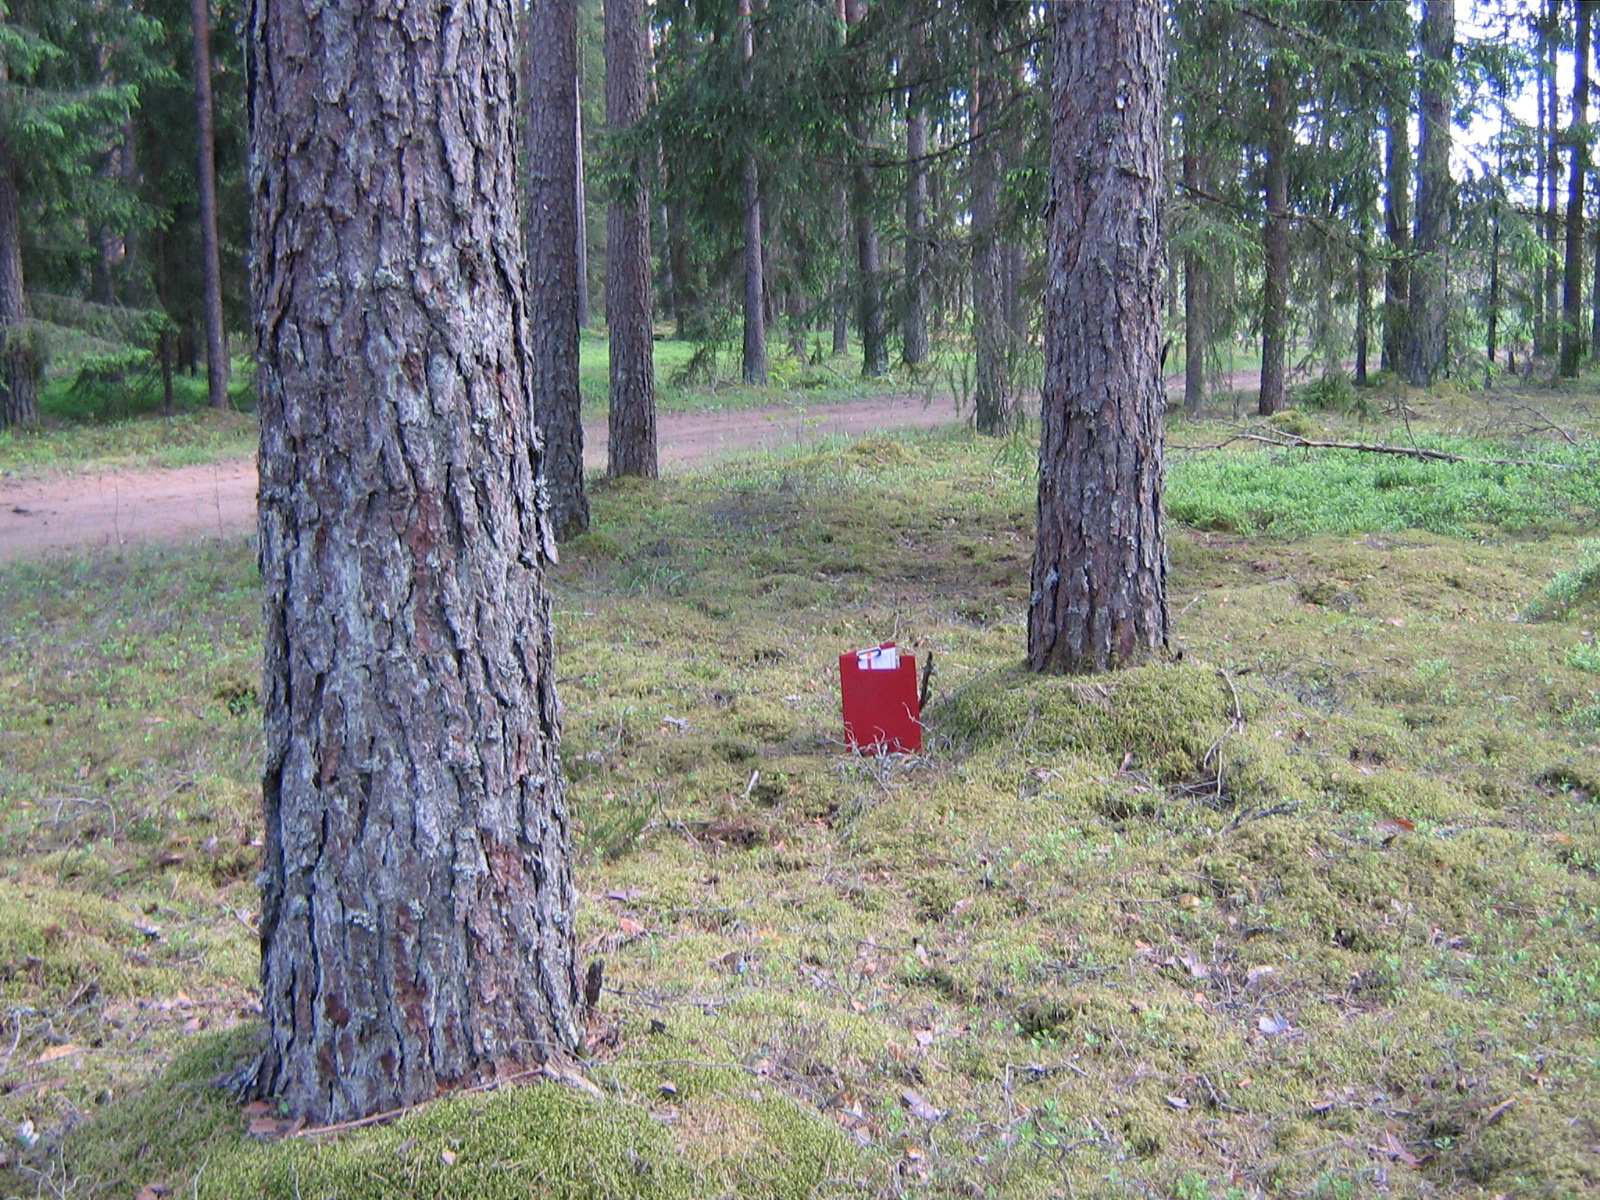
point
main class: Woodland
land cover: Pine dominated coniferous woodland
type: hemiboreal forest and nemoral coniferous forest and mixed broadleaved-coniferous forest
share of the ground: > 75 %
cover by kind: coniferous forest trees 80 %, herbaceous plants 10 %, lichens and mosses 10 %
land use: Forestry
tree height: > 5 m
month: June
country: LV
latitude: 56.6469
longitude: 25.5318
